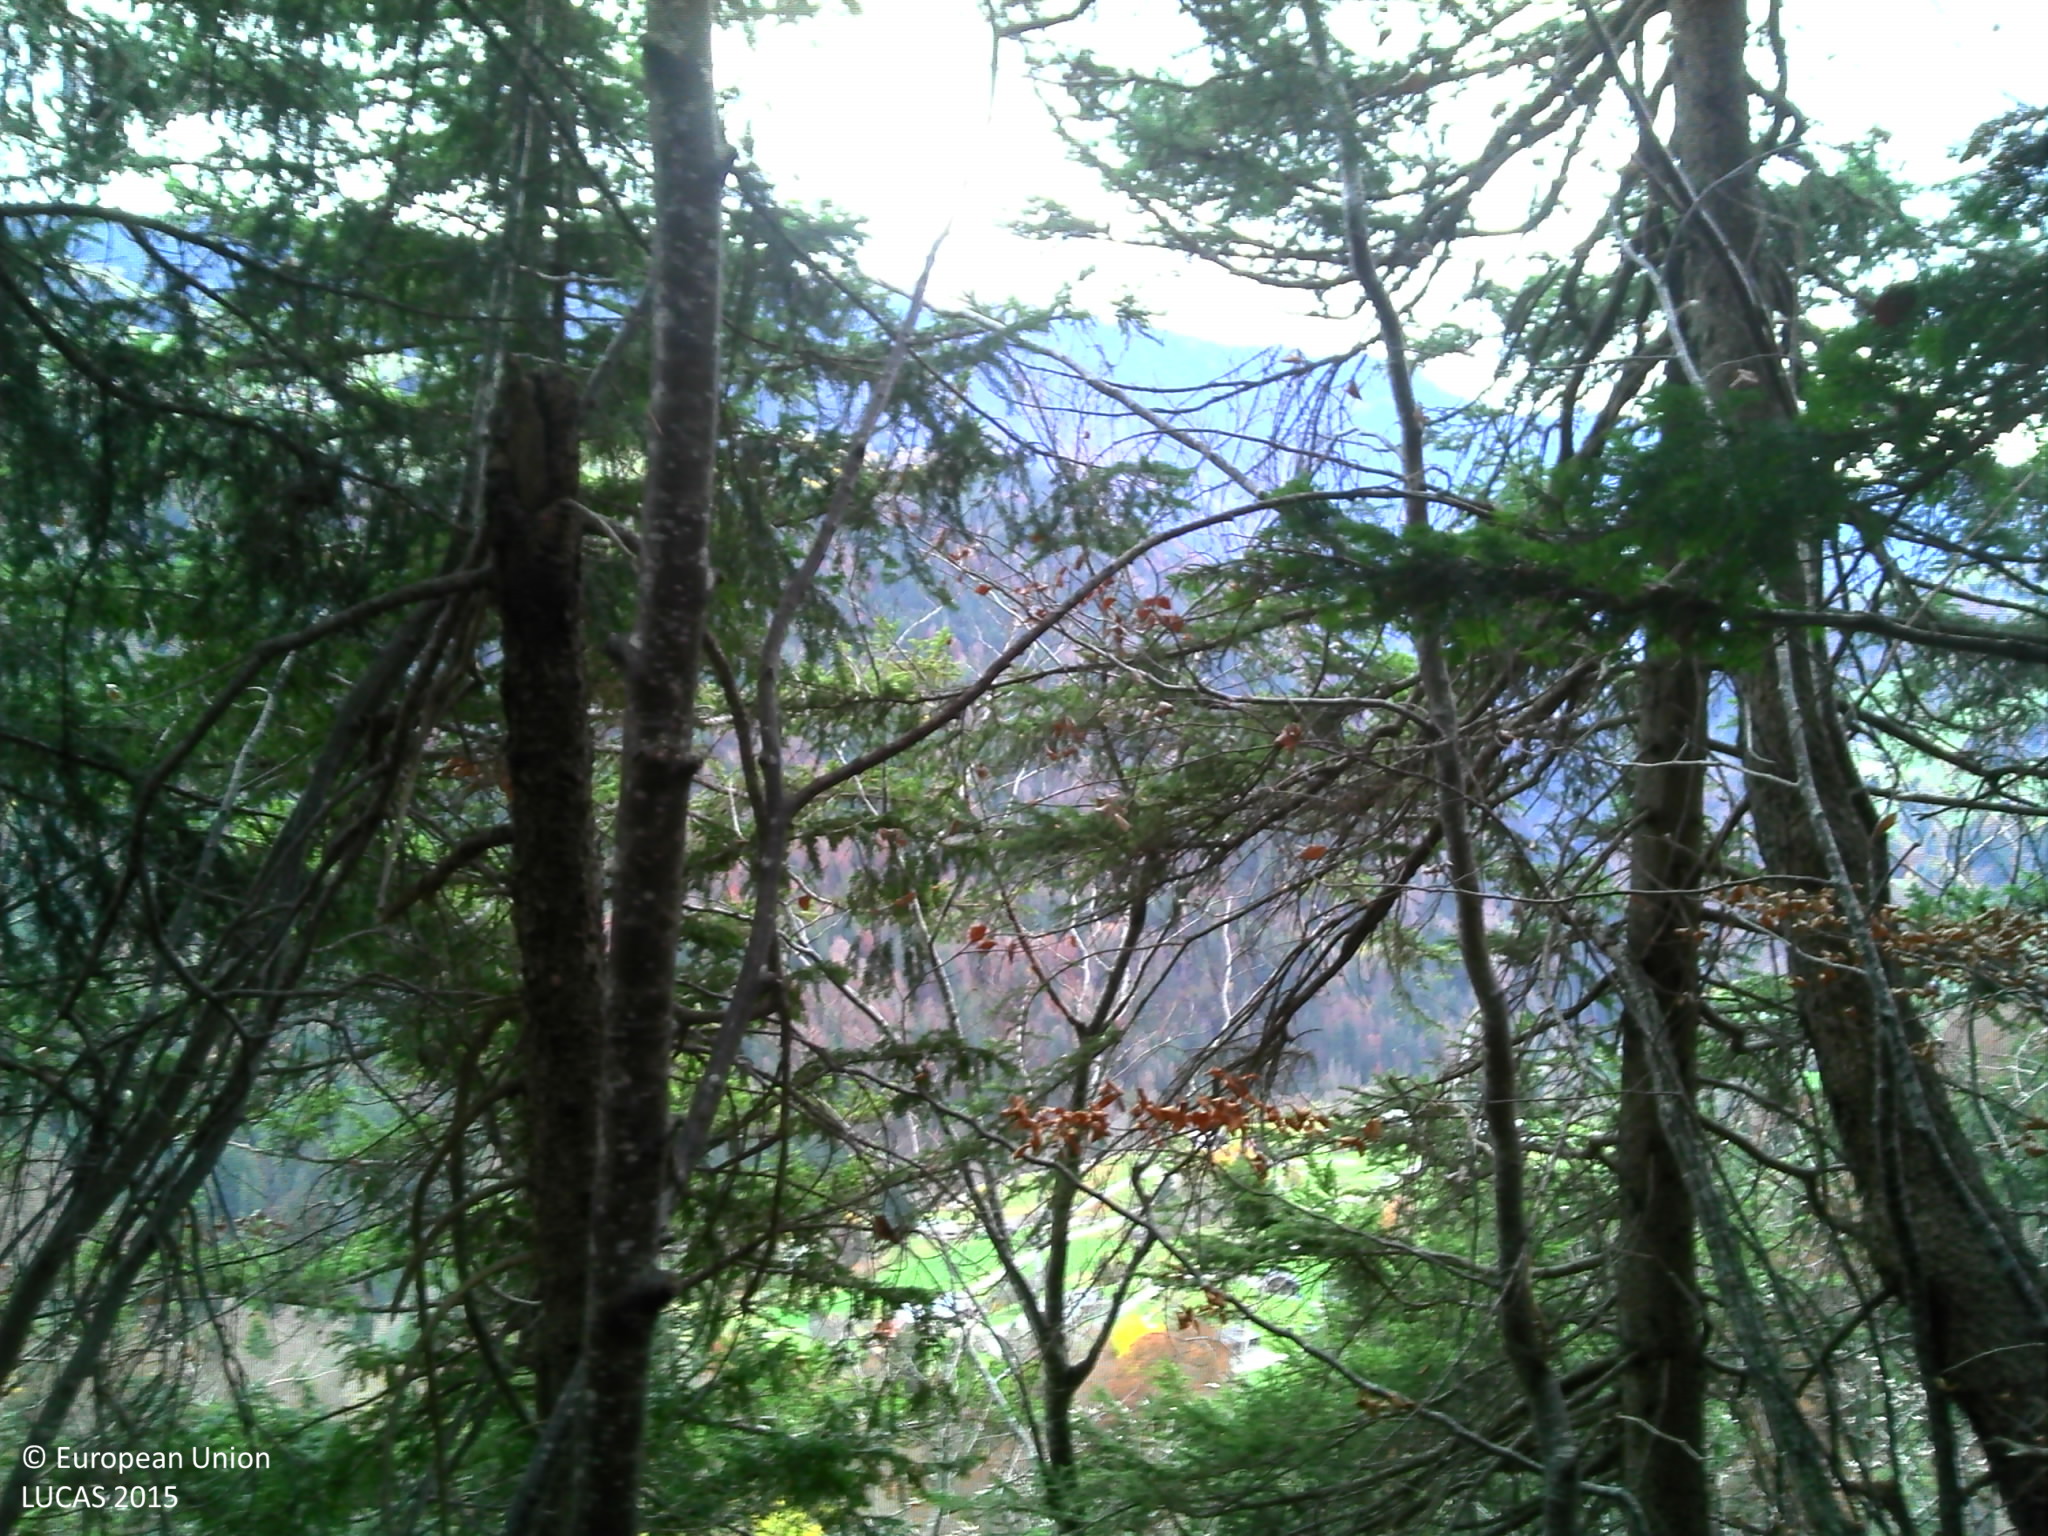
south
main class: Woodland
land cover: Spruce dominated mixed woodland
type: mountainous beech forest
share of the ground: > 75 %
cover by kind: coniferous forest trees 50 %, broadleaved forest trees 30 %, herbaceous plants 10 %, consolidated bare surface 10 %
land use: Forestry
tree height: > 5 m
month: November
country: FR
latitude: 45.8068
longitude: 6.4912
